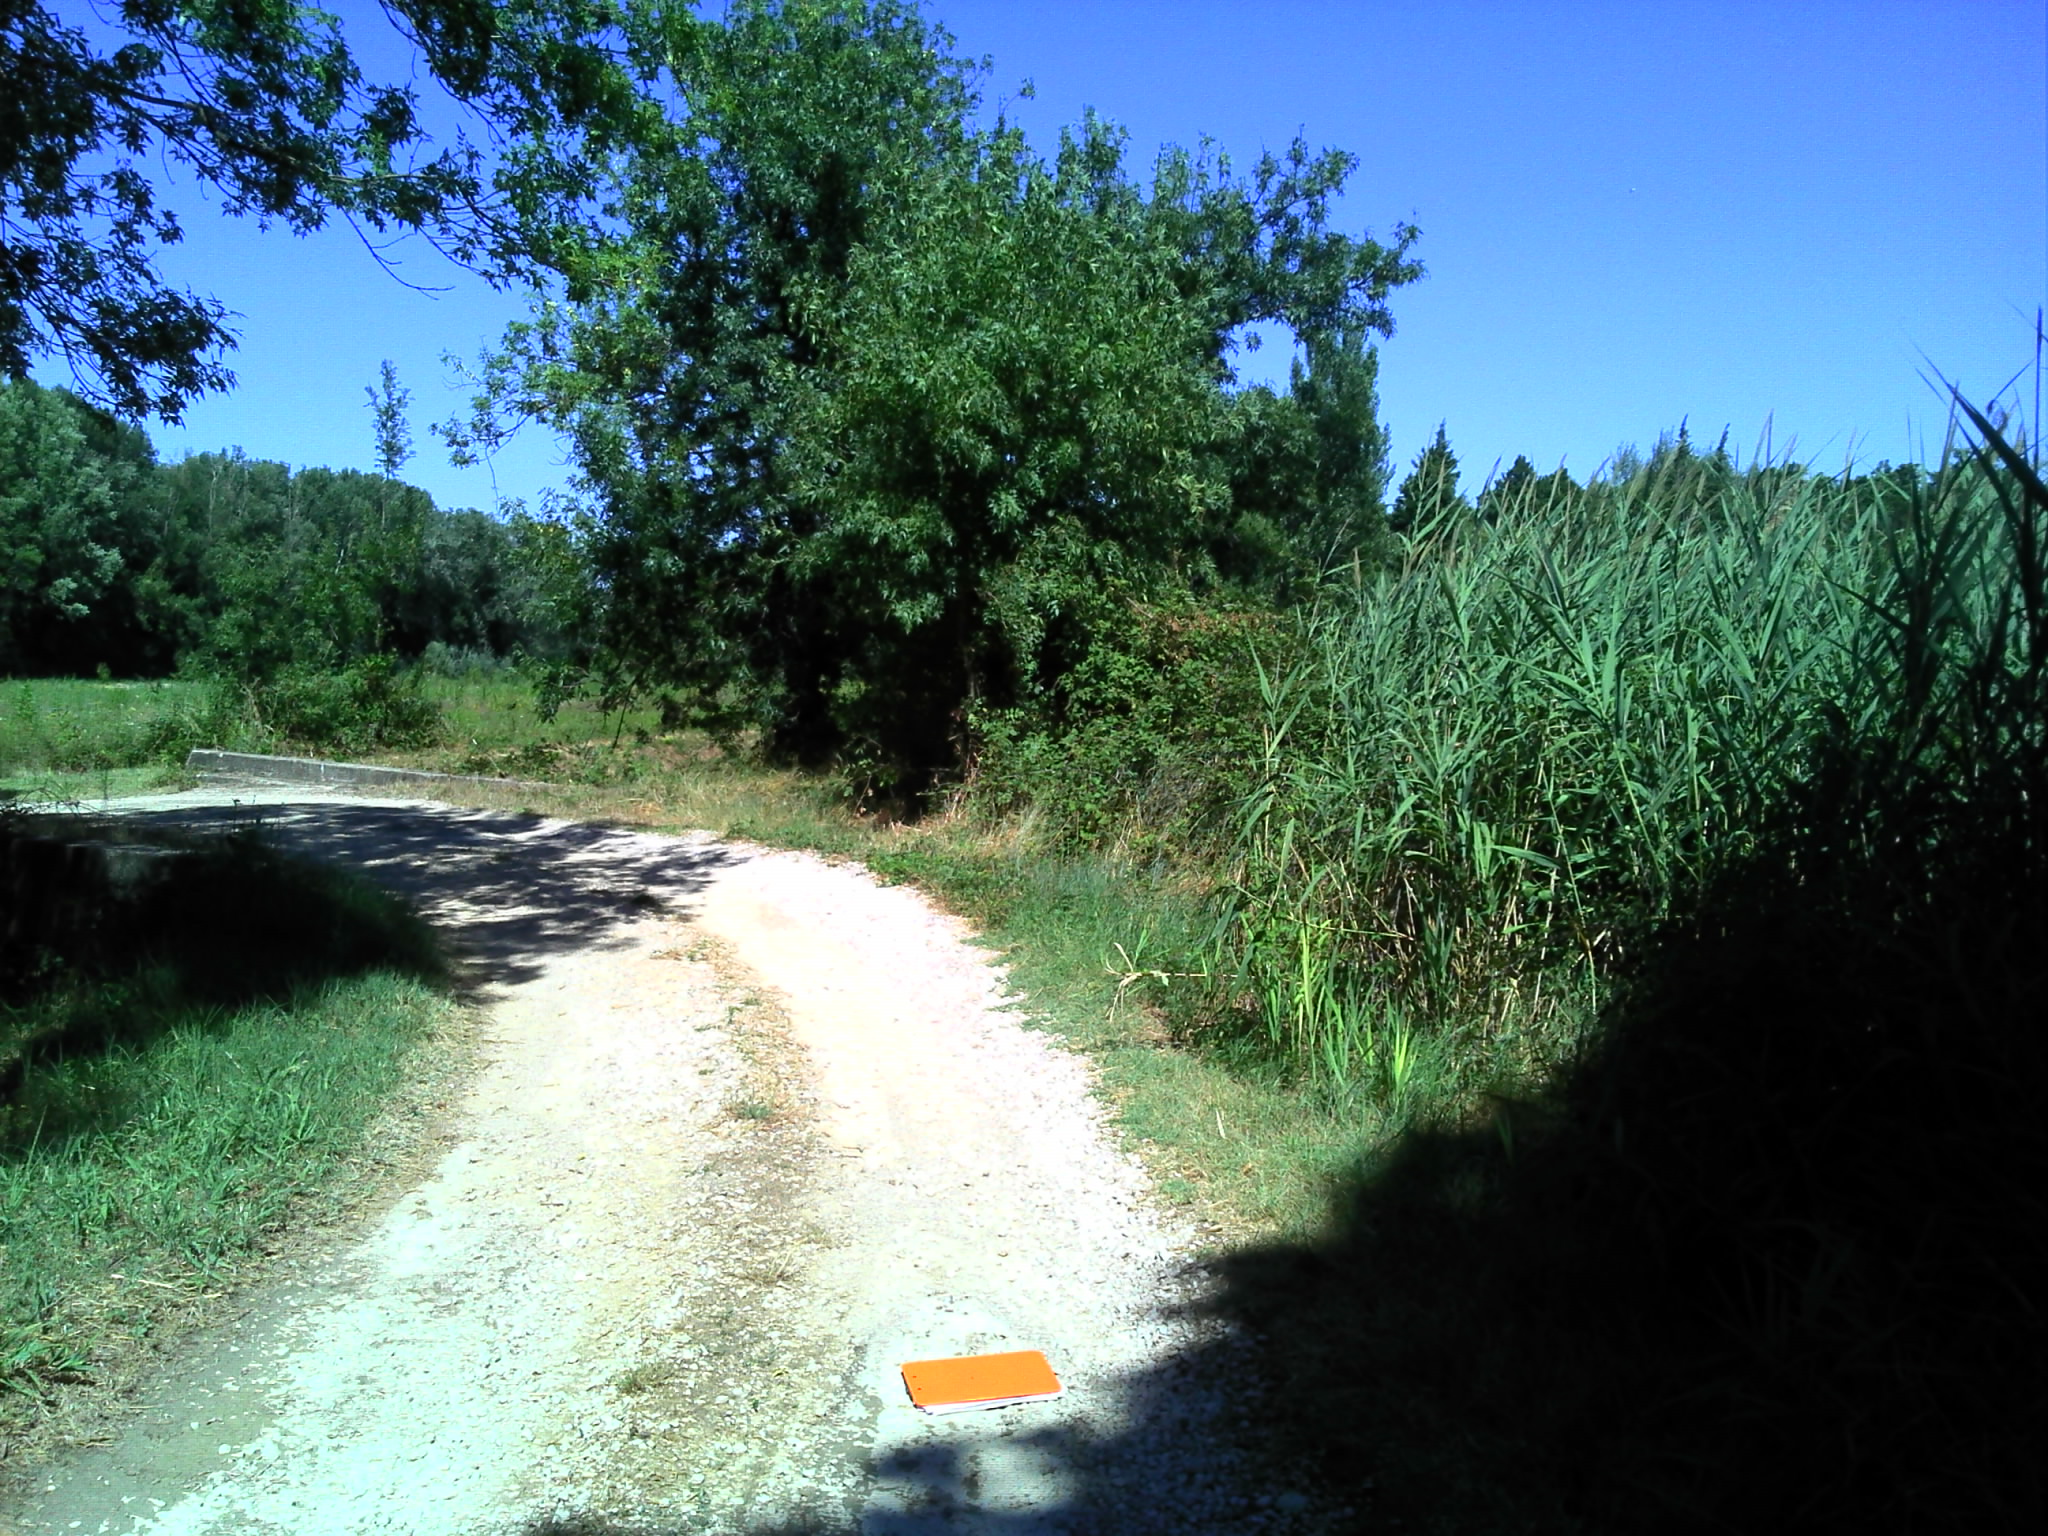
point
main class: Woodland
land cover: Broadleaved woodland
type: broadleaved evergreen forest
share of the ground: > 75 %
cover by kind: broadleaved forest trees 70 %, herbaceous plants 20 %, consolidated bare surface 10 %
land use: Semi-natural and natural areas not in use
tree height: > 5 m
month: August
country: FR
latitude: 43.9999
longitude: 4.7332
